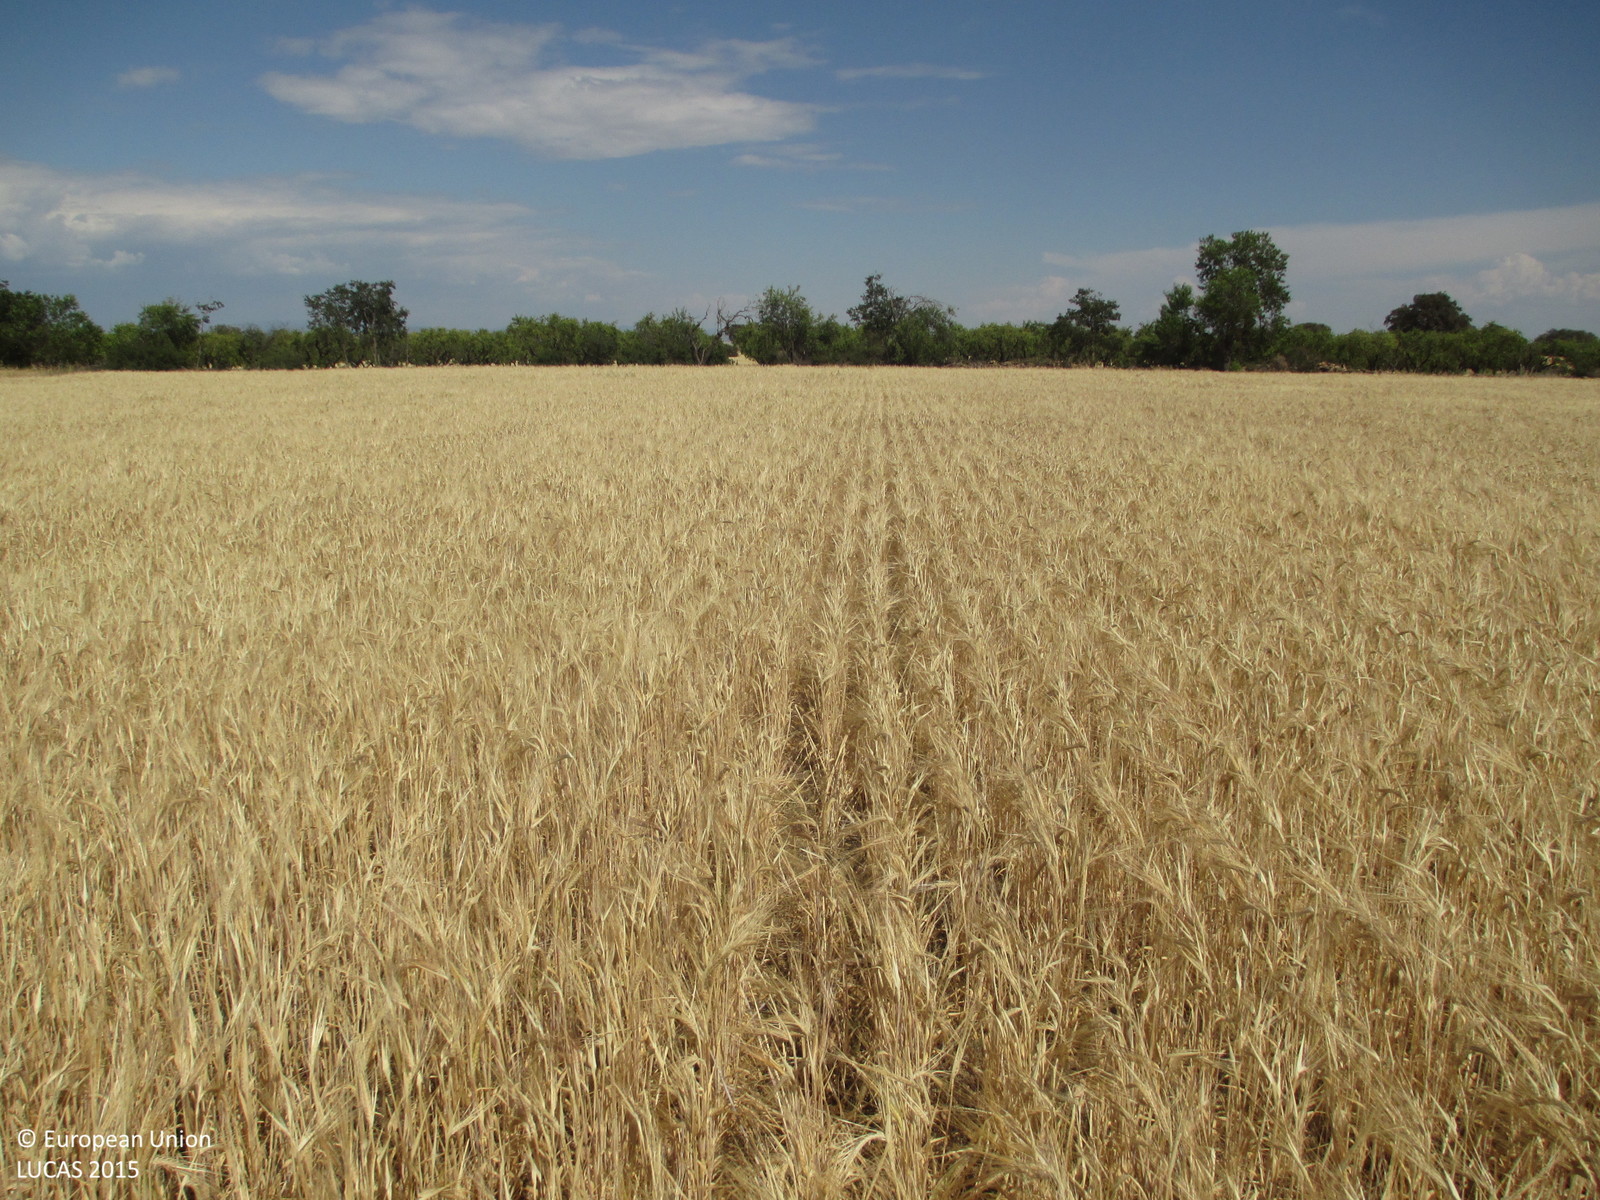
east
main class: Cropland
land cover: Barley
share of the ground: > 75 %
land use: Agriculture (excluding fallow land and kitchen gardens)
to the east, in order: Barley; Shruby margins; Abandoned hedges; Dry stone walls; Nuts trees; Spontaneously vegetated surfaces; Tracks; Spontaneously vegetated surfaces
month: May
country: ES
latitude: 41.9225
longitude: 0.0099
